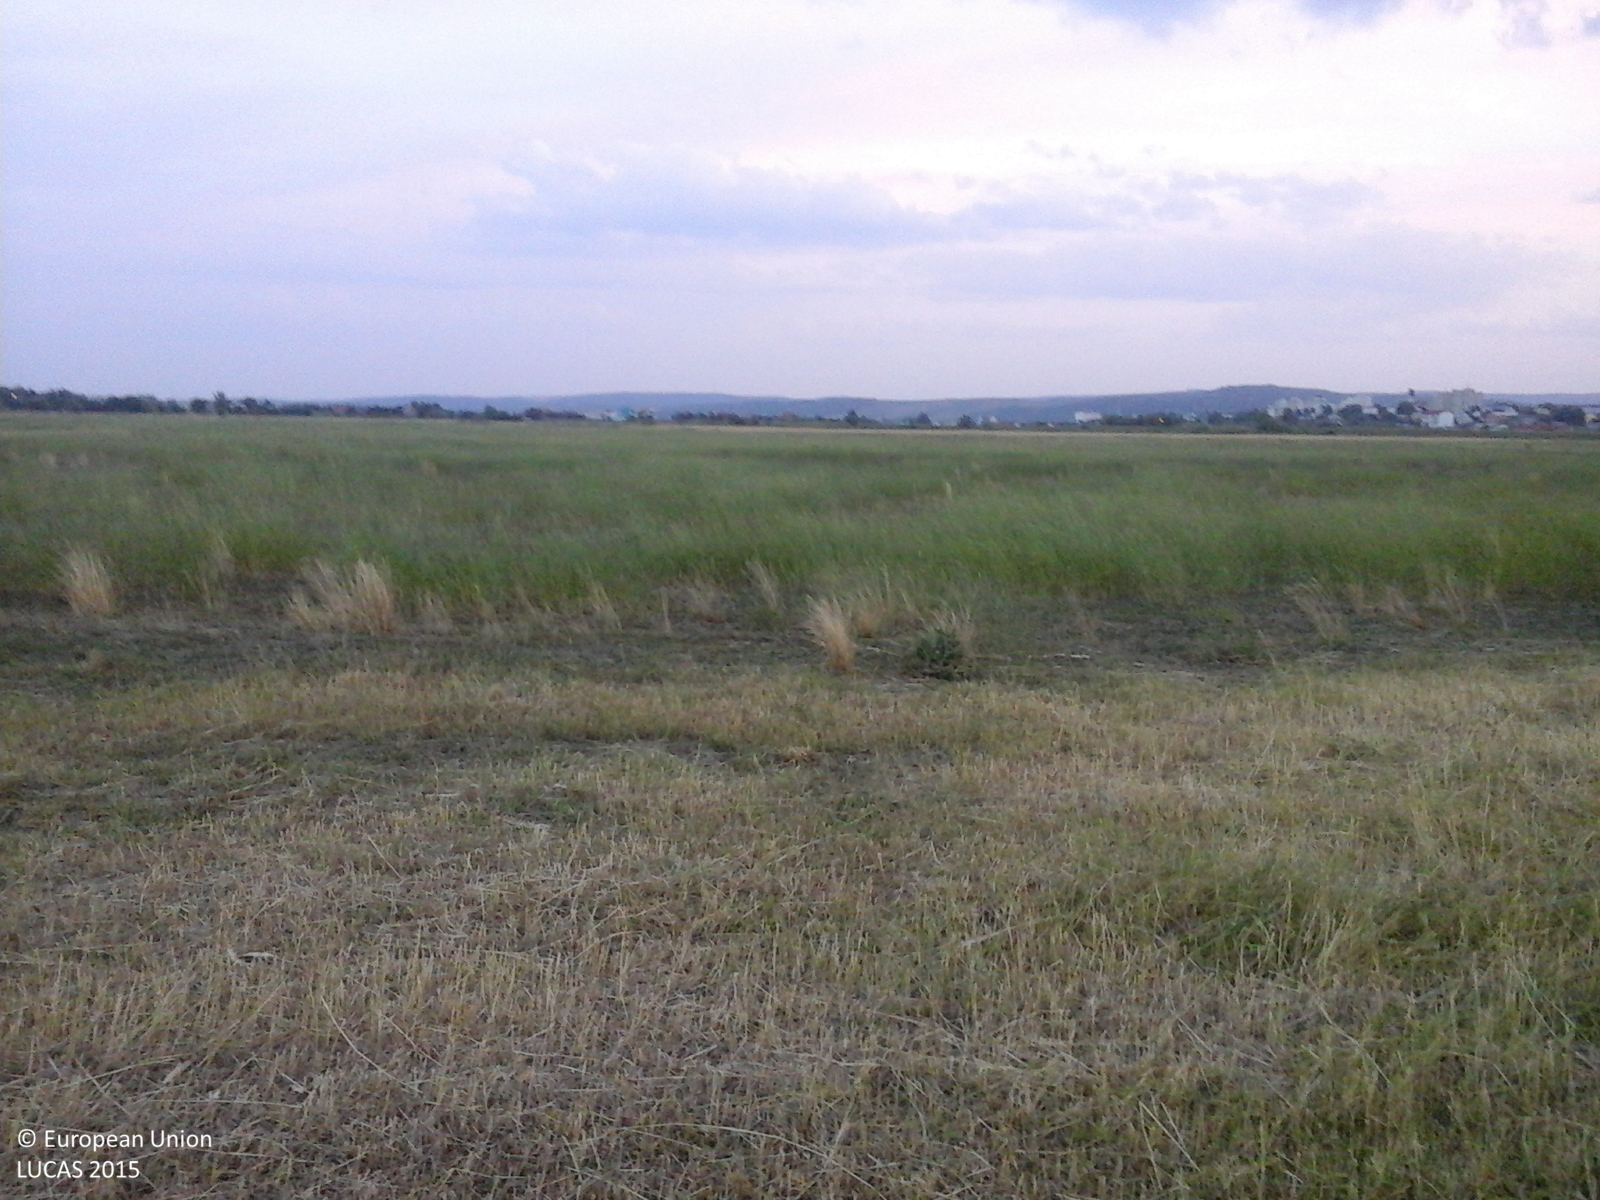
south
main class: Grassland
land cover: Grassland without tree/shrub cover
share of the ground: 10 - 25 %
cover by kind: herbaceous plants 100 %
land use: Agriculture (excluding fallow land and kitchen gardens)
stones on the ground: < 10 %
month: June
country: RO
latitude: 46.6571
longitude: 27.7483
